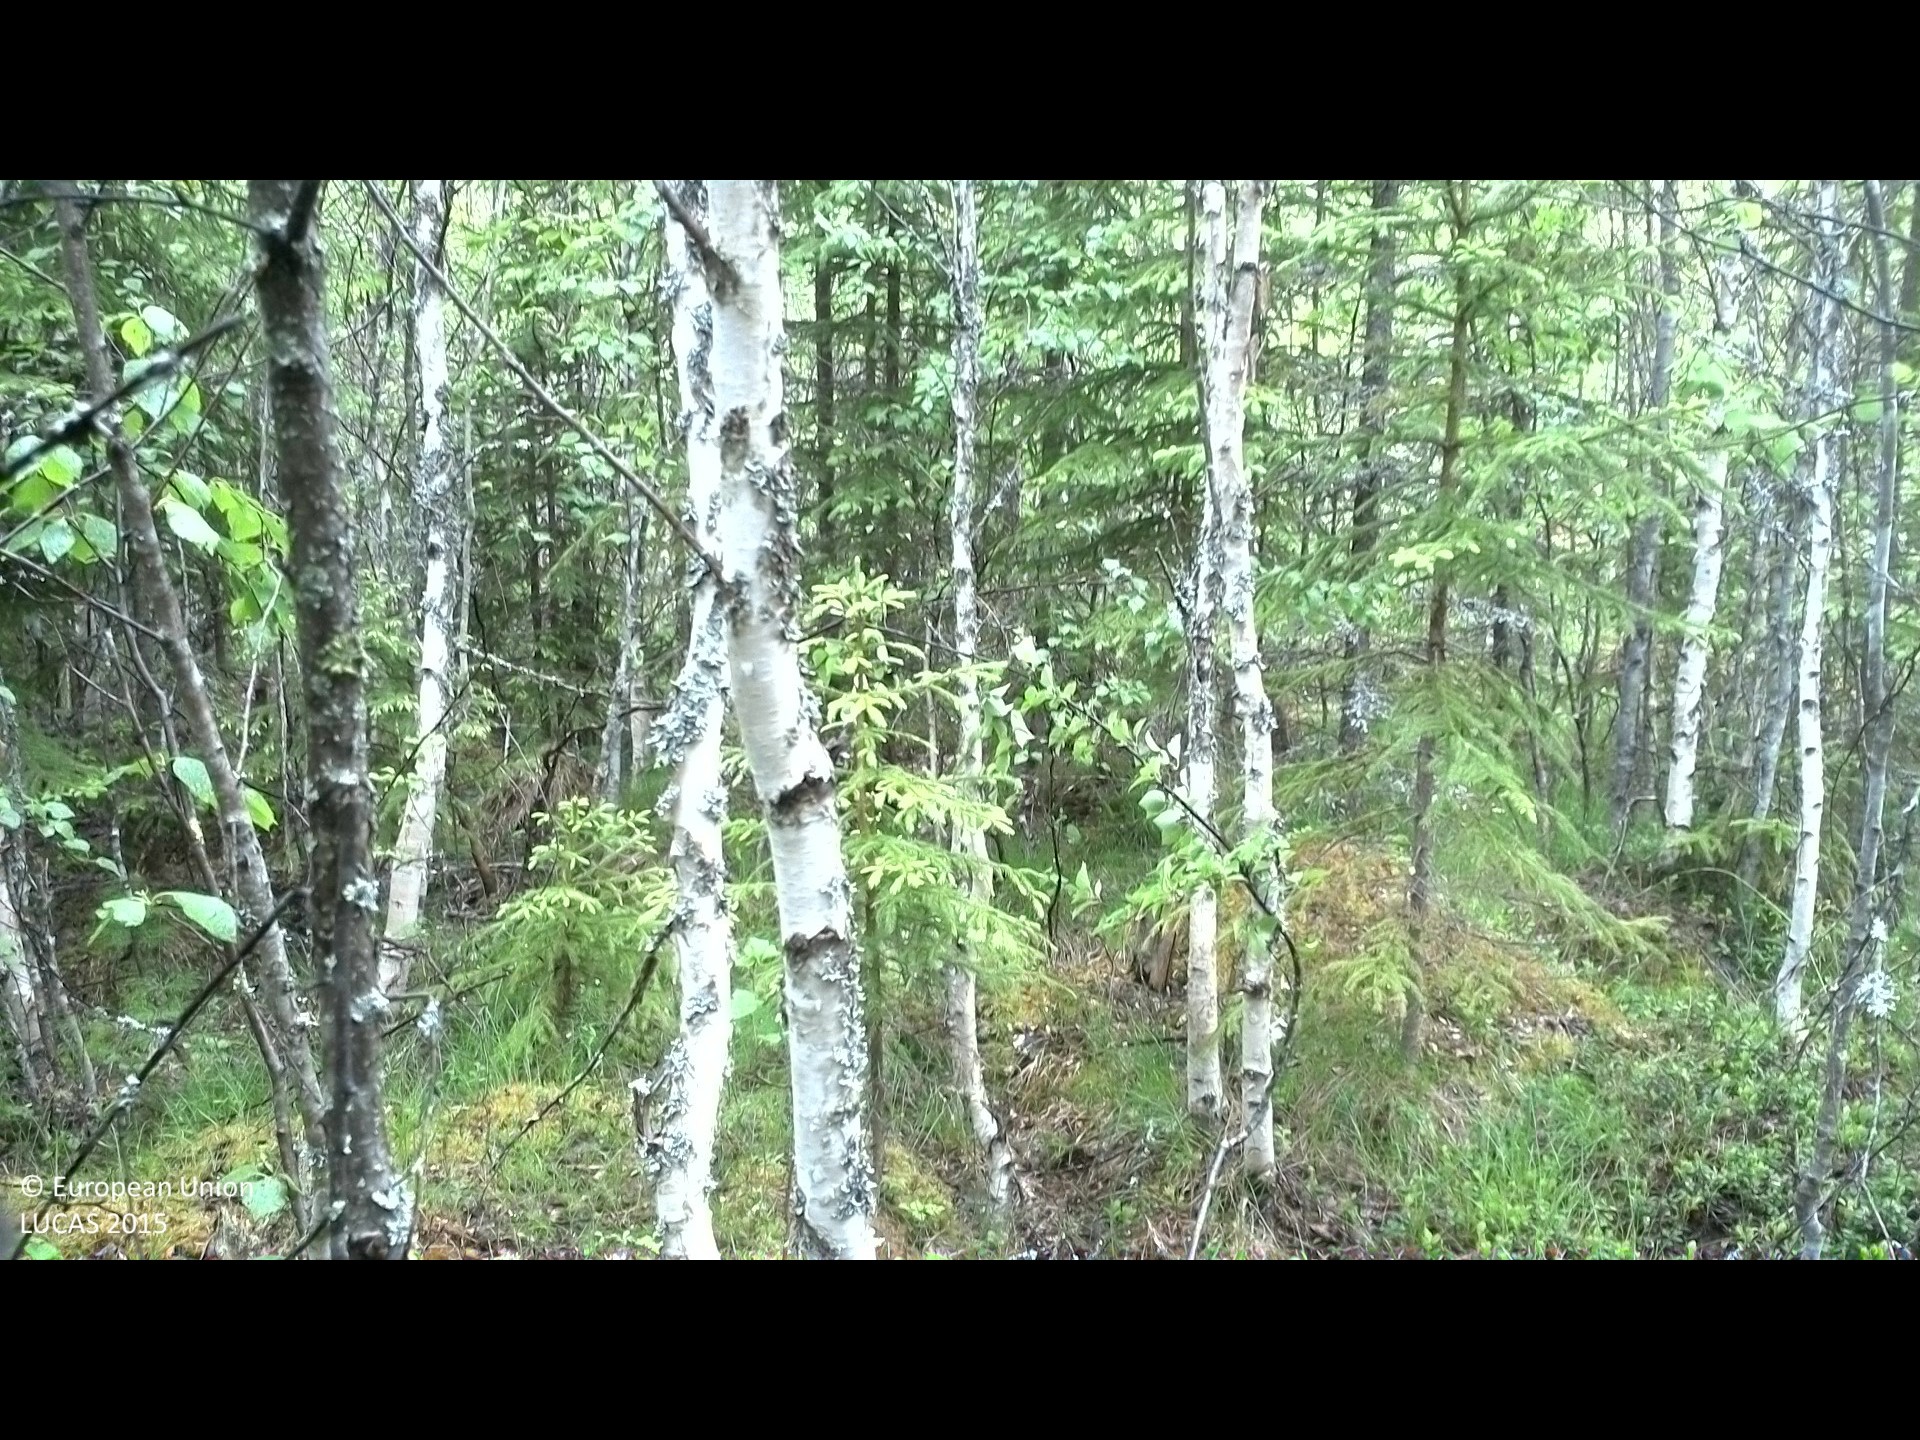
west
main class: Woodland
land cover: Spruce dominated mixed woodland
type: boreal forest
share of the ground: > 75 %
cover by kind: broadleaved forest trees 60 %, coniferous forest trees 20 %, shrubs 20 %
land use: Forestry
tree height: > 5 m
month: June
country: SE
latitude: 61.9633
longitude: 16.9432
